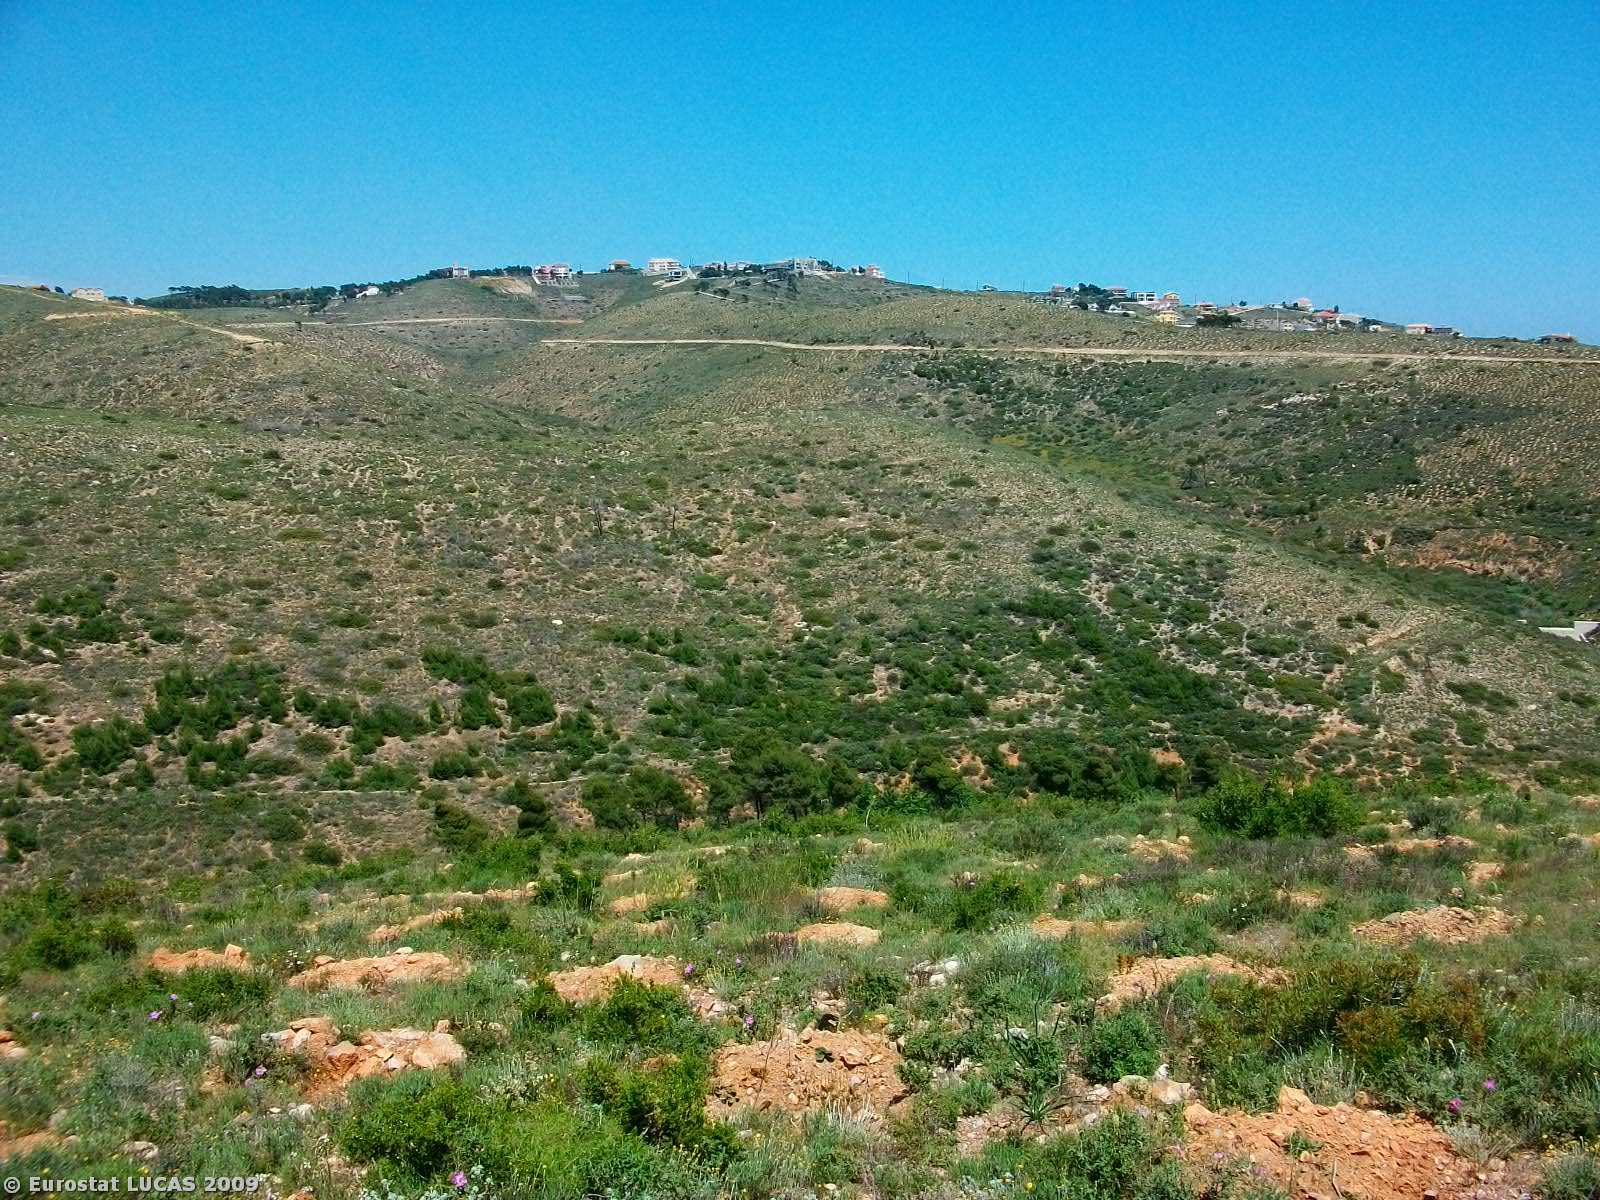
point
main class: Shrubland
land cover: Shrubland without tree cover
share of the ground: > 75 %
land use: Unused
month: May
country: GR
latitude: 38.0342
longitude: 23.9634
